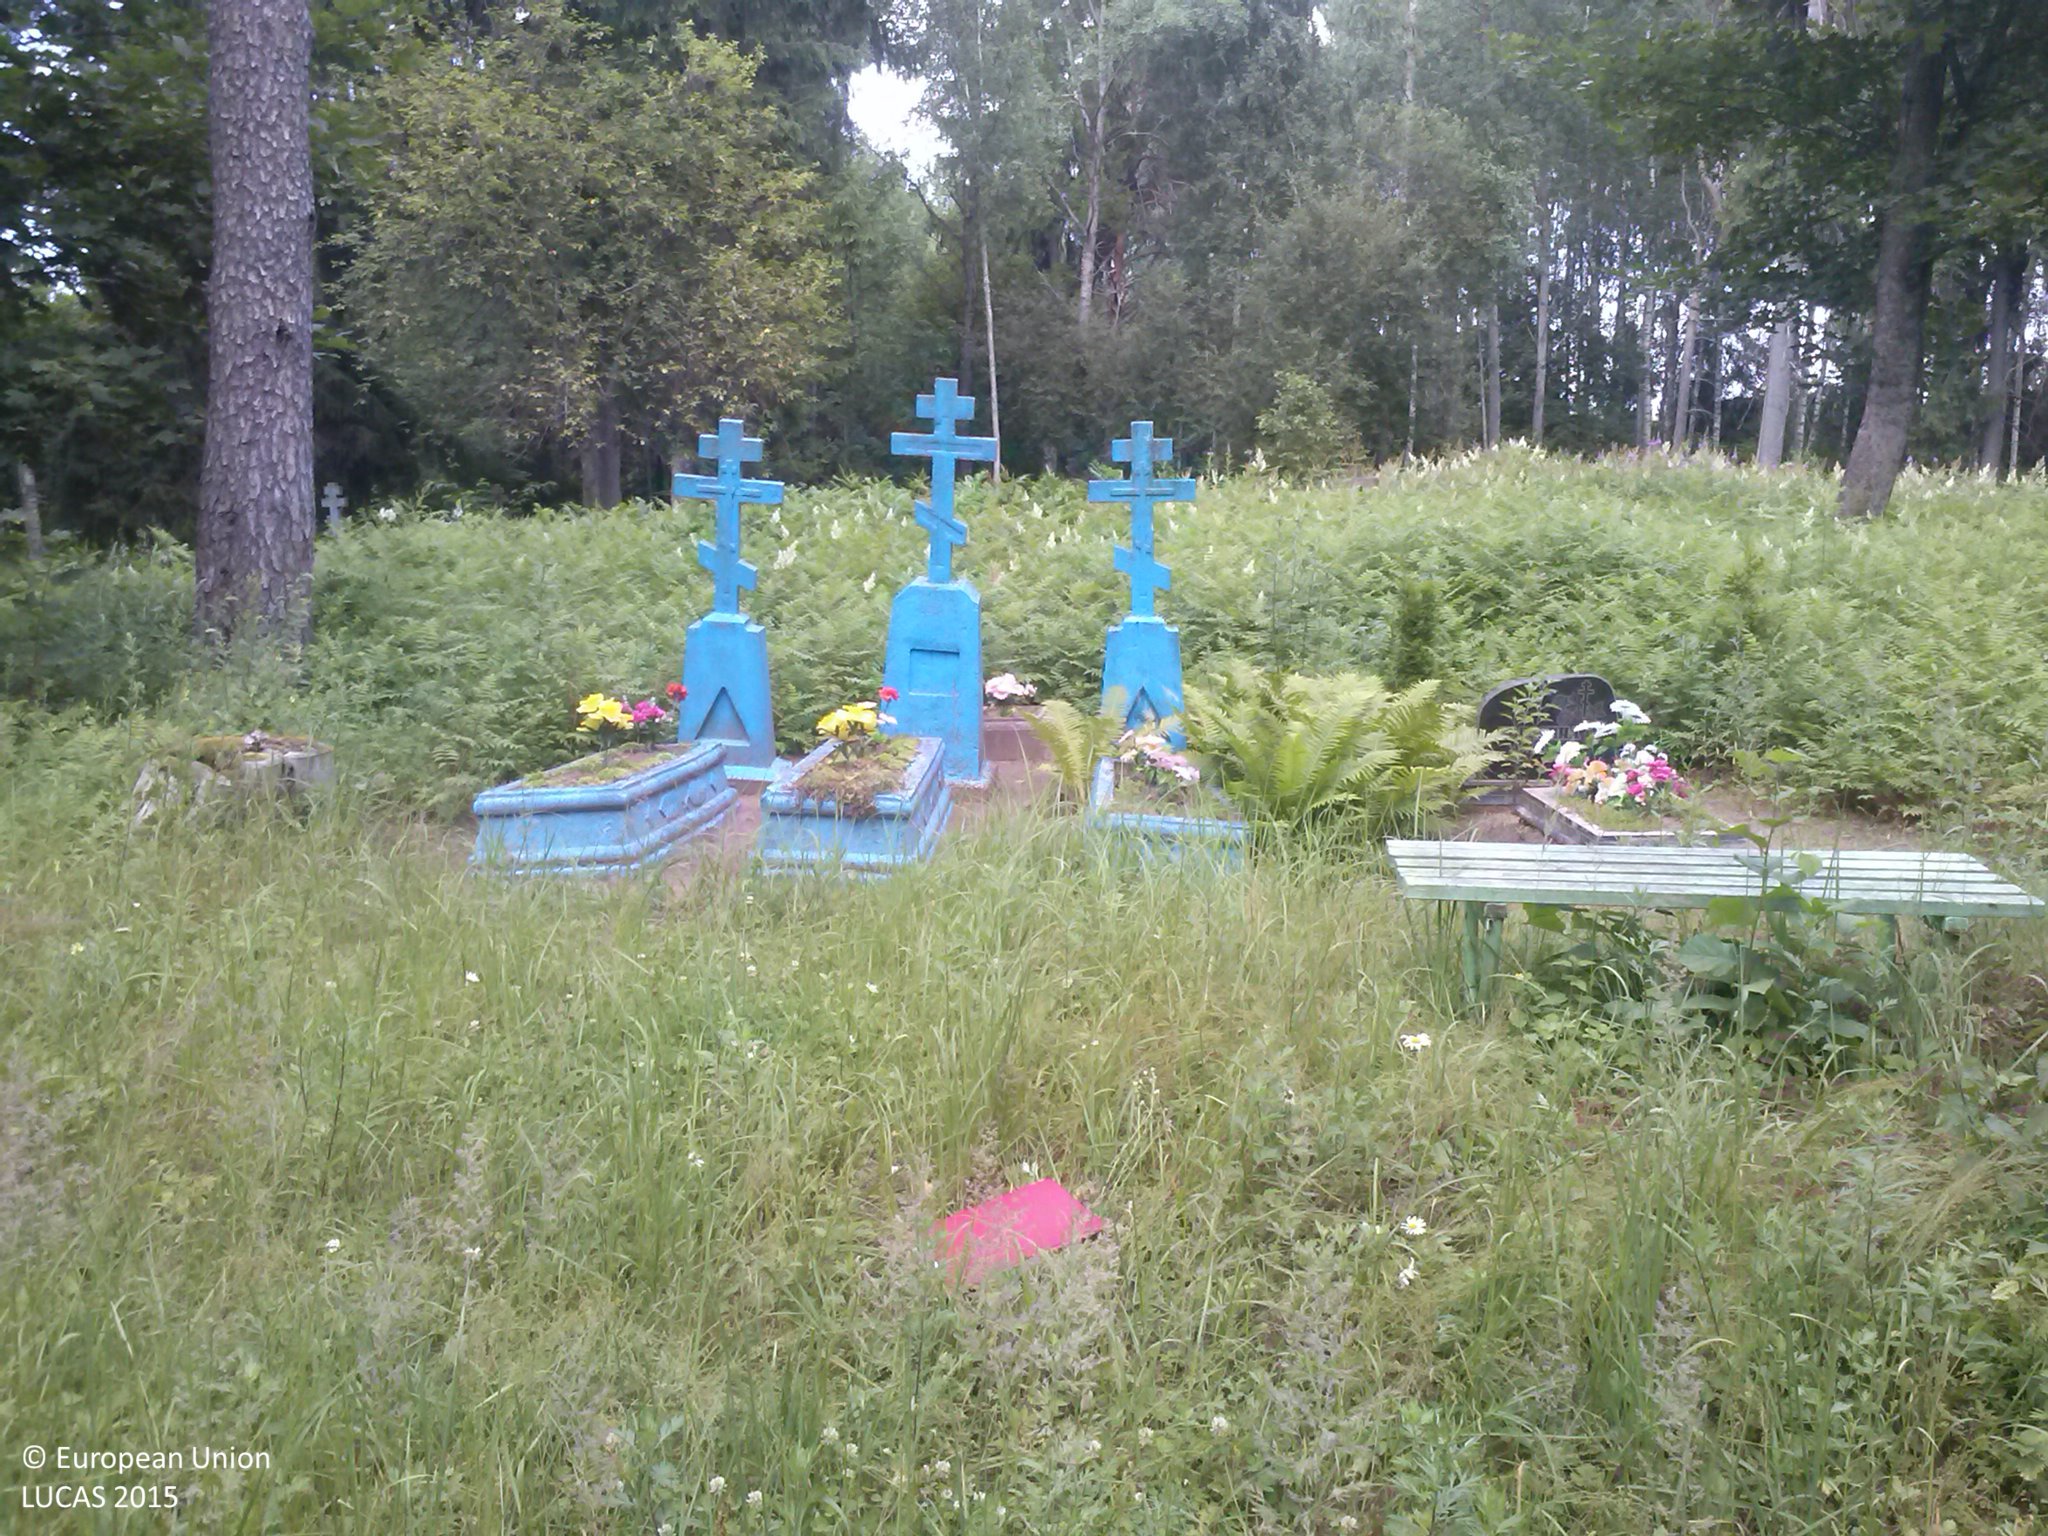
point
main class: Grassland
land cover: Grassland without tree/shrub cover
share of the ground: > 75 %
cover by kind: herbaceous plants 100 %
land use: Community services
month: July
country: LV
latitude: 56.5477
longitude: 27.0314
